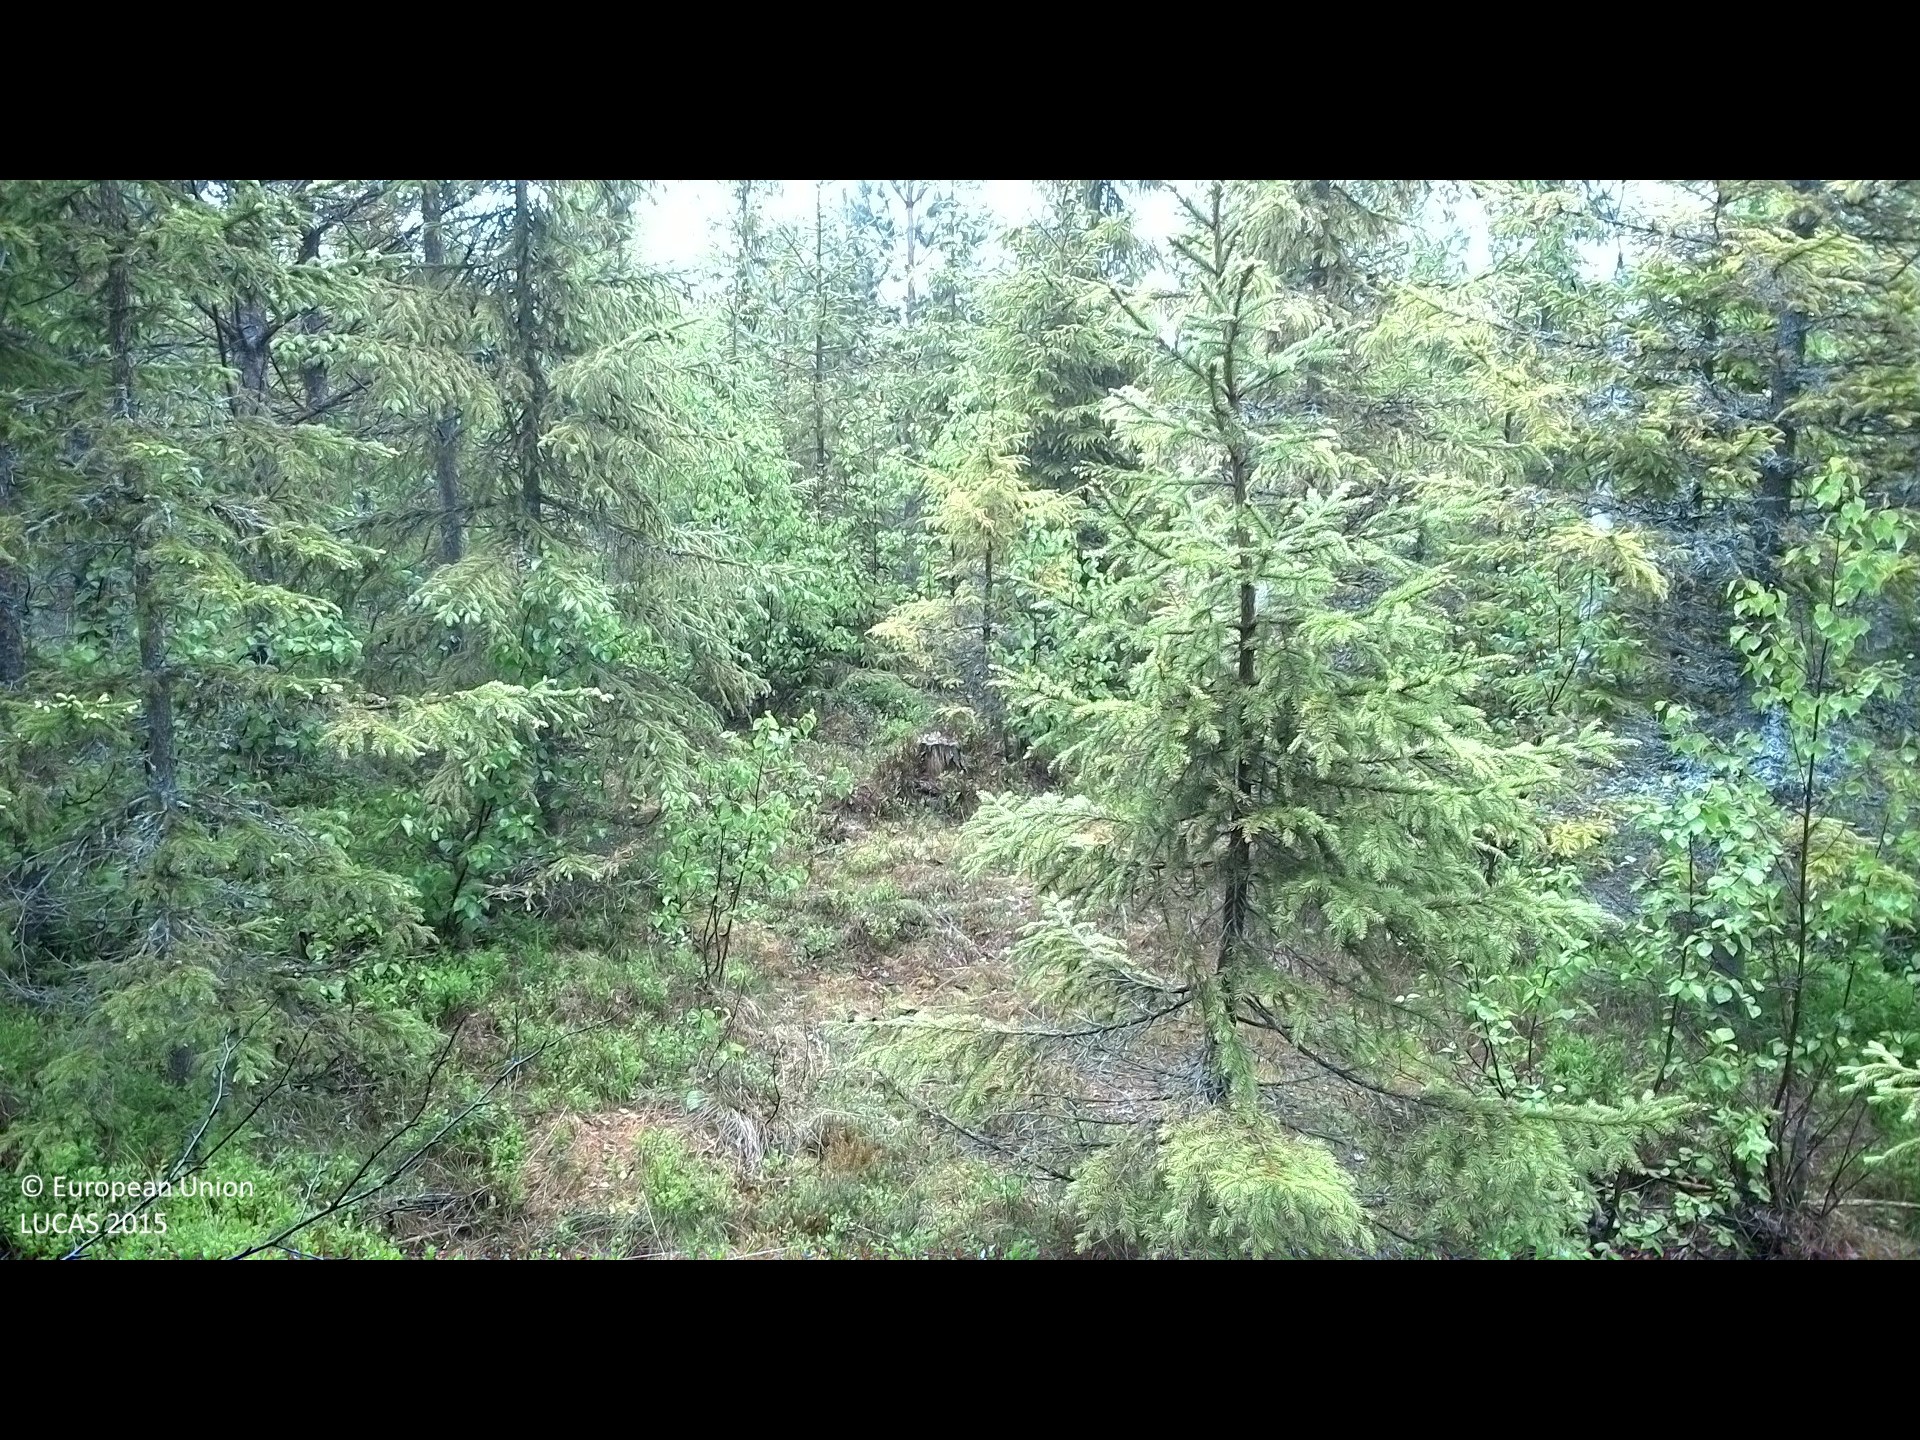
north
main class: Woodland
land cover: Spruce dominated mixed woodland
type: boreal forest
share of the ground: 25 - 50 %
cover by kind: shrubs 50 %, coniferous forest trees 25 %, broadleaved forest trees 15 %, lichens and mosses 10 %
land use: Forestry
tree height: > 5 m
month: June
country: SE
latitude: 62.1532
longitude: 17.1395
